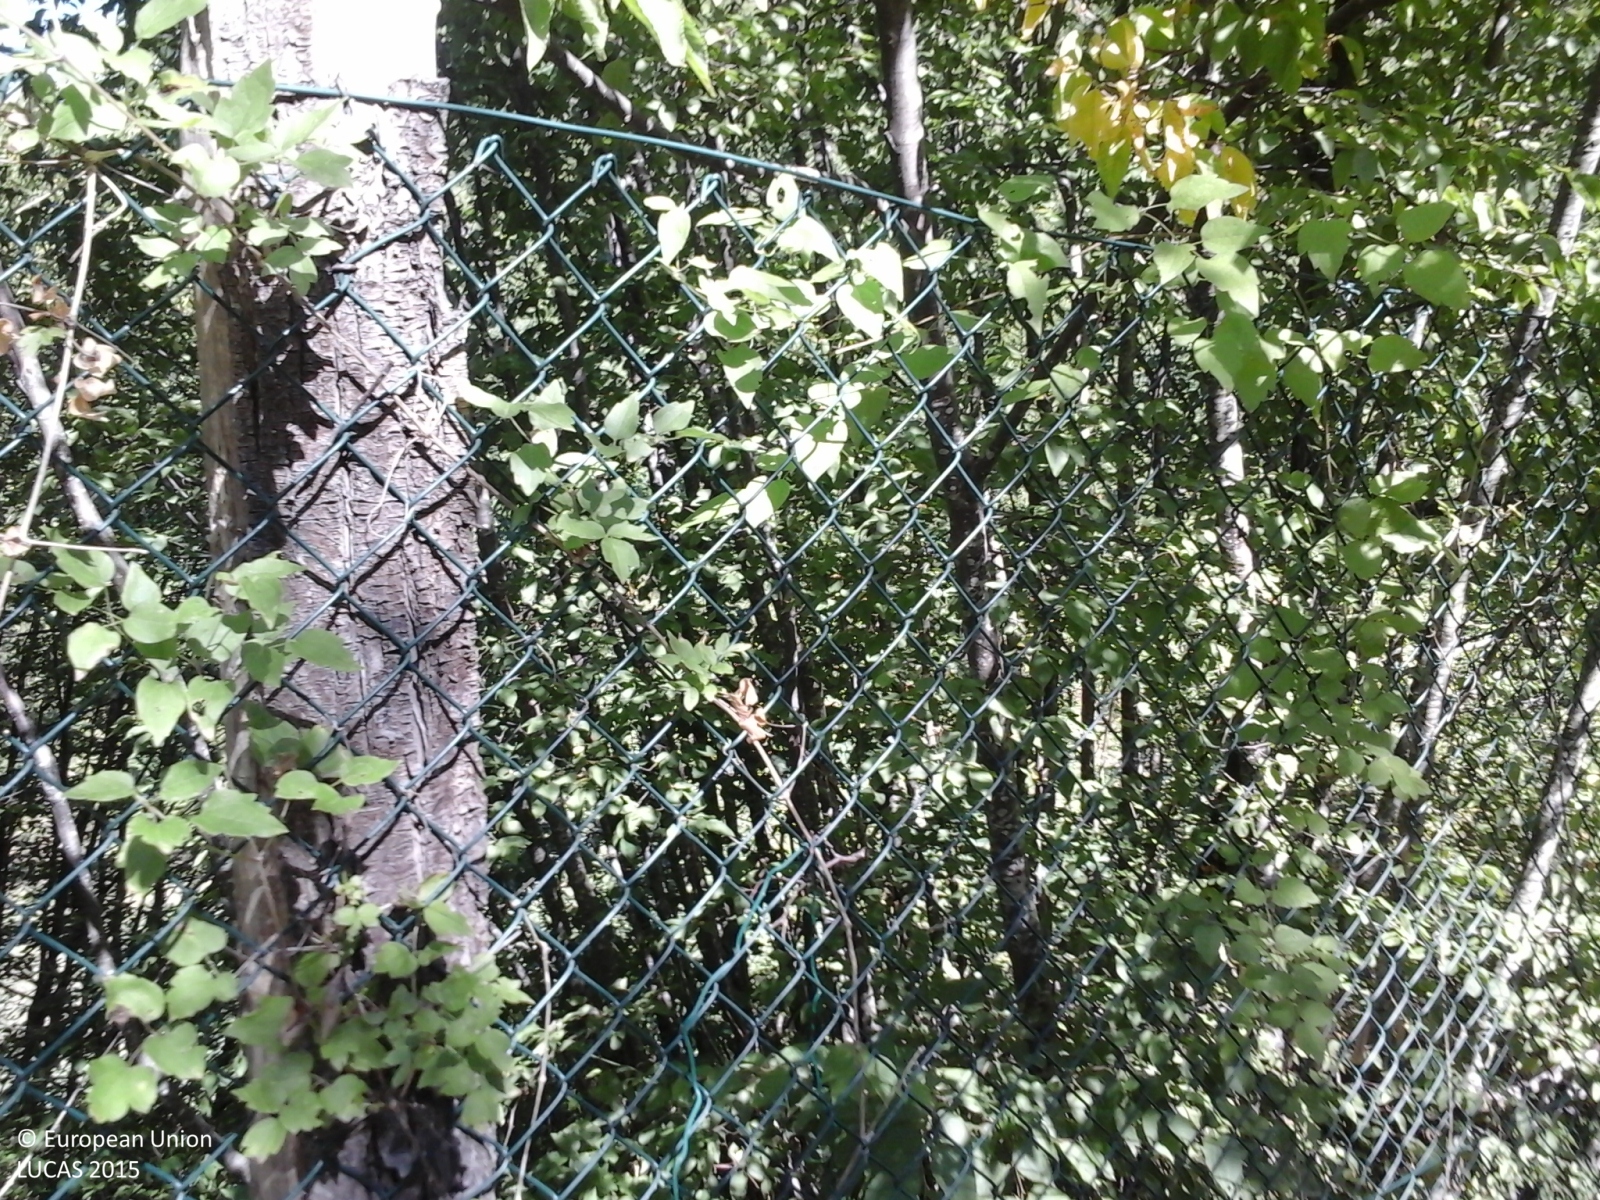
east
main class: Woodland
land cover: Broadleaved woodland
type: thermophilous deciduous forest
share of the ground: > 75 %
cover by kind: broadleaved forest trees 100 %
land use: Forestry
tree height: > 5 m
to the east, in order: Broadleaved woodland; Grassland without tree/shrub cover; Broadleaved woodland; Fences; Paved roads, cycling and walking lanes; Broadleaved woodland; Shrubland without tree cover; Broadleaved woodland; Grassland without tree/shrub cover; Broadleaved woodland
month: August
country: IT
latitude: 43.5297
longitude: 12.3572
